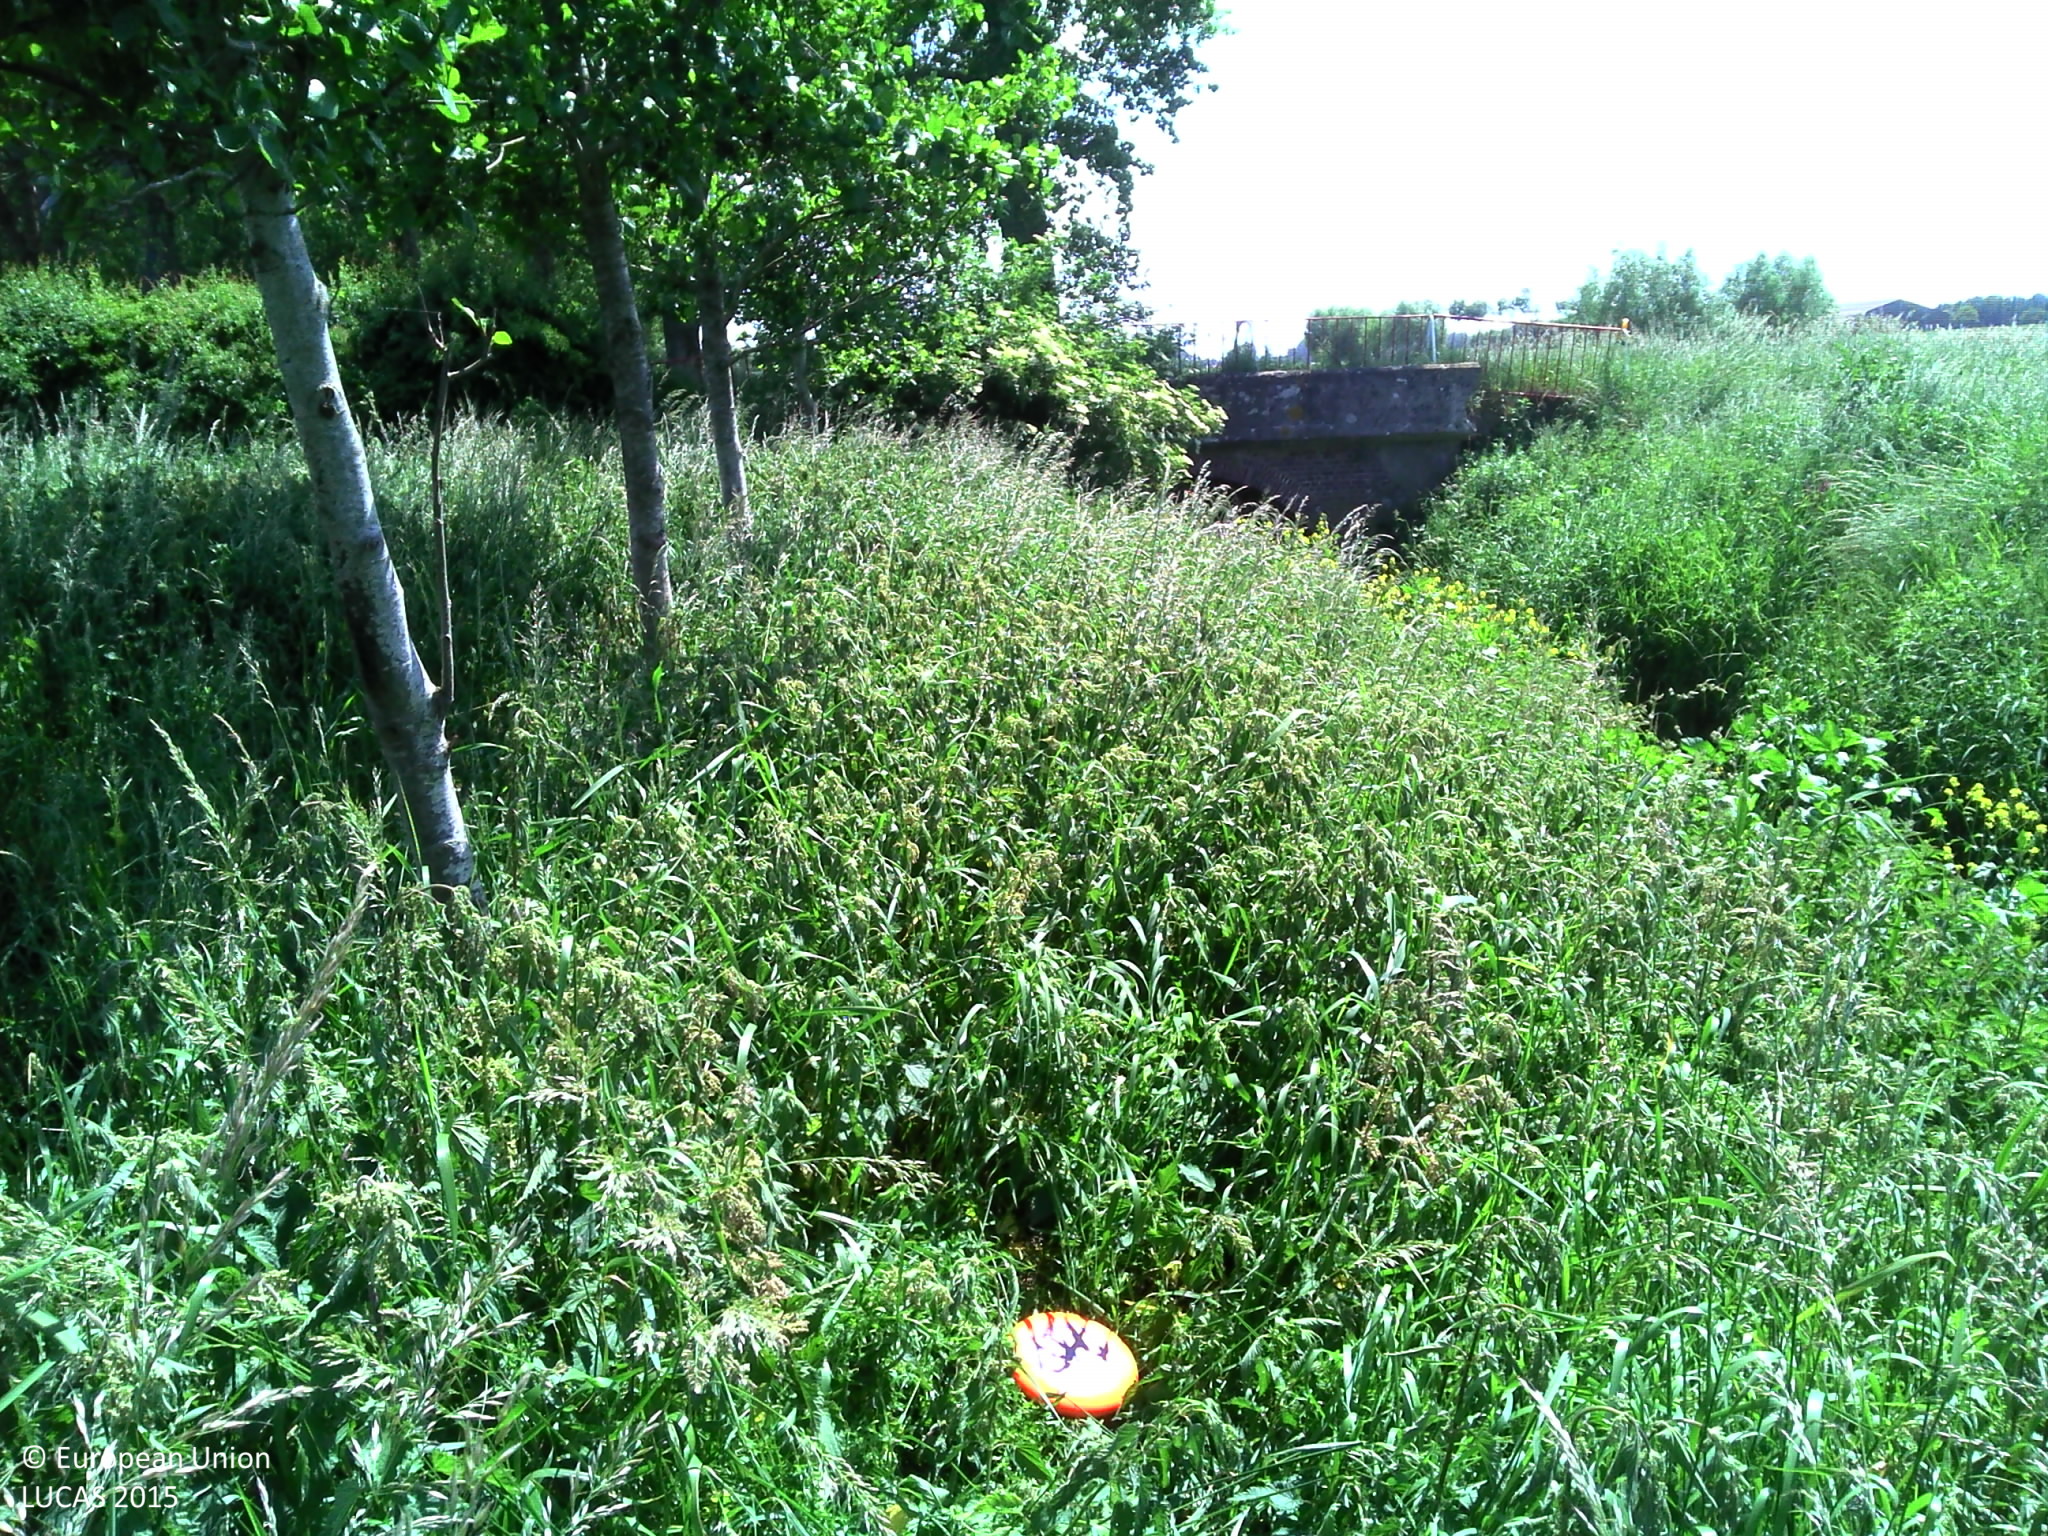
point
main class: Grassland
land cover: Spontaneously vegetated surfaces
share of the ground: > 75 %
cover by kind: herbaceous plants 100 %
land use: Semi-natural and natural areas not in use
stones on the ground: < 10 %
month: June
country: BE
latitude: 50.8779
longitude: 2.8117
